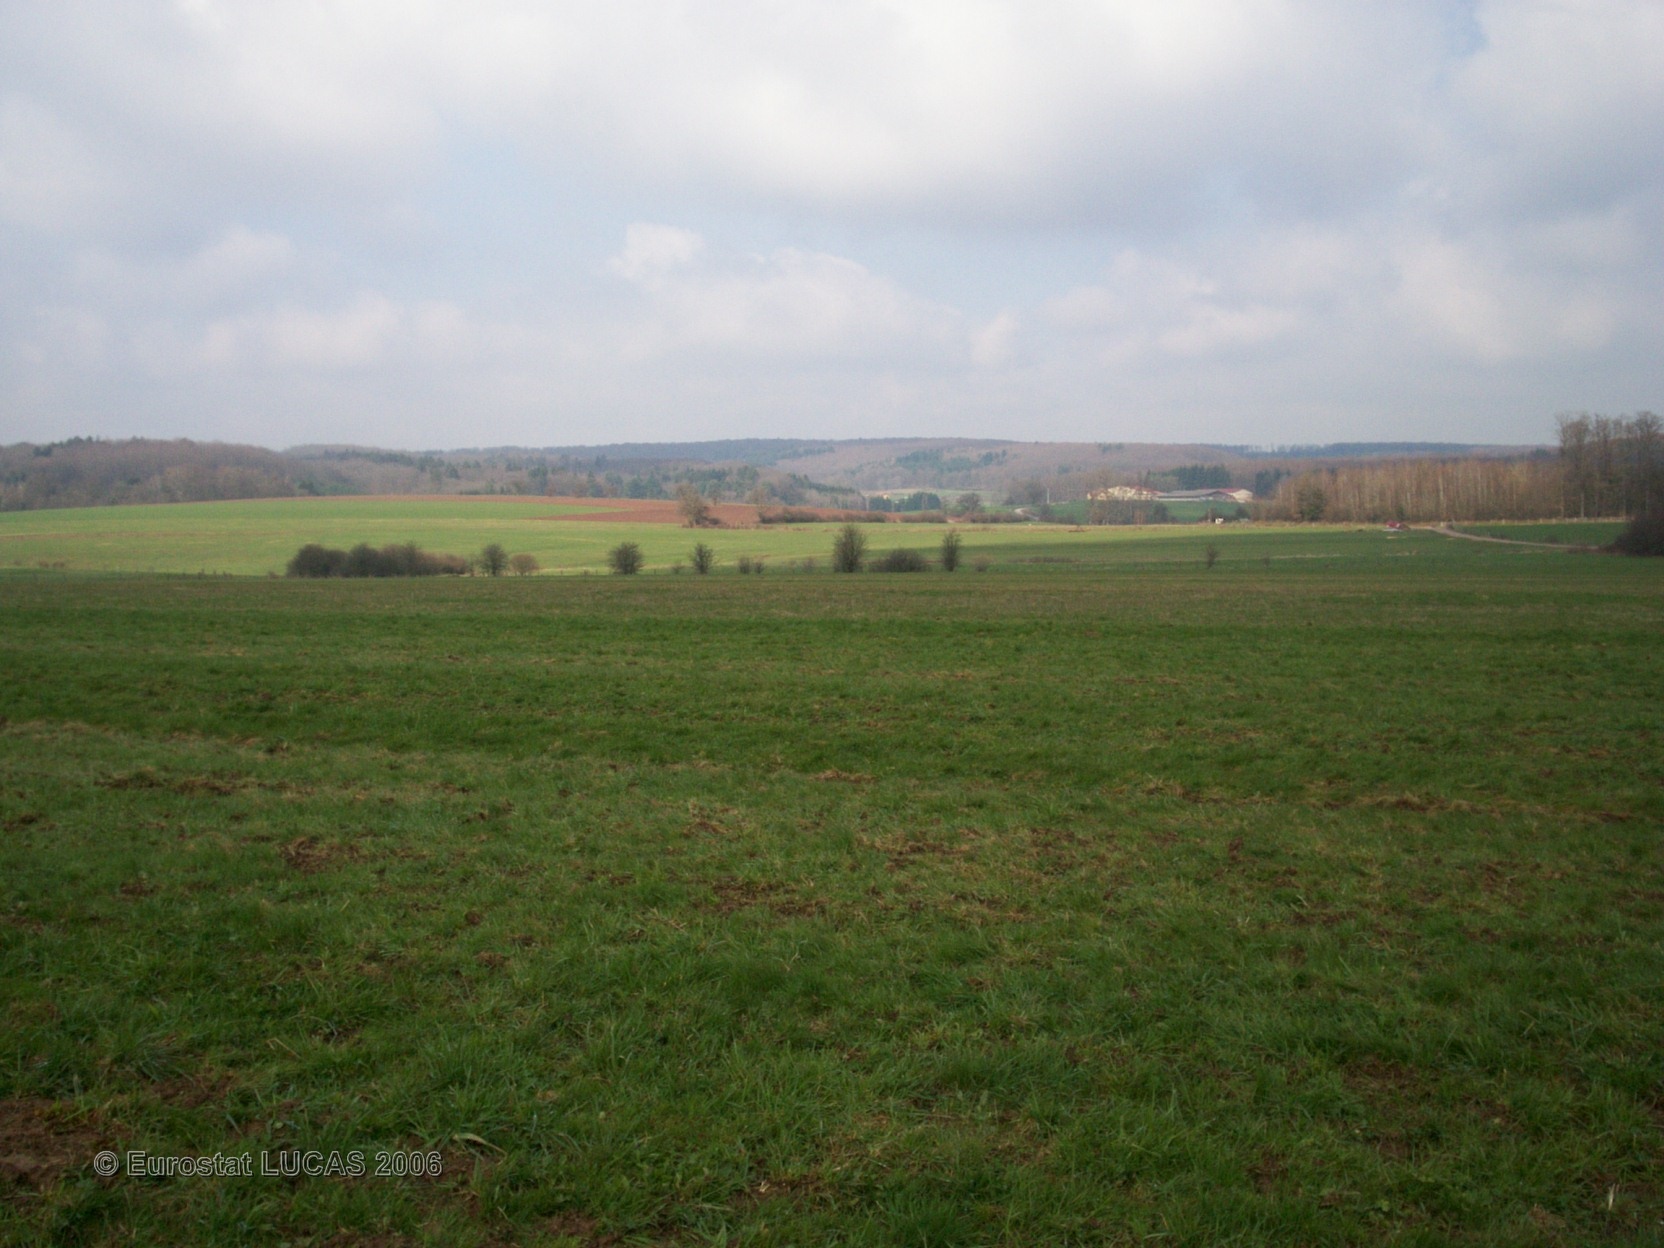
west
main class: Grassland
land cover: Grassland without tree/shrub cover
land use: Agriculture (excluding fallow land and kitchen gardens)
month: April
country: FR
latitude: 48.0879
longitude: 6.2550
